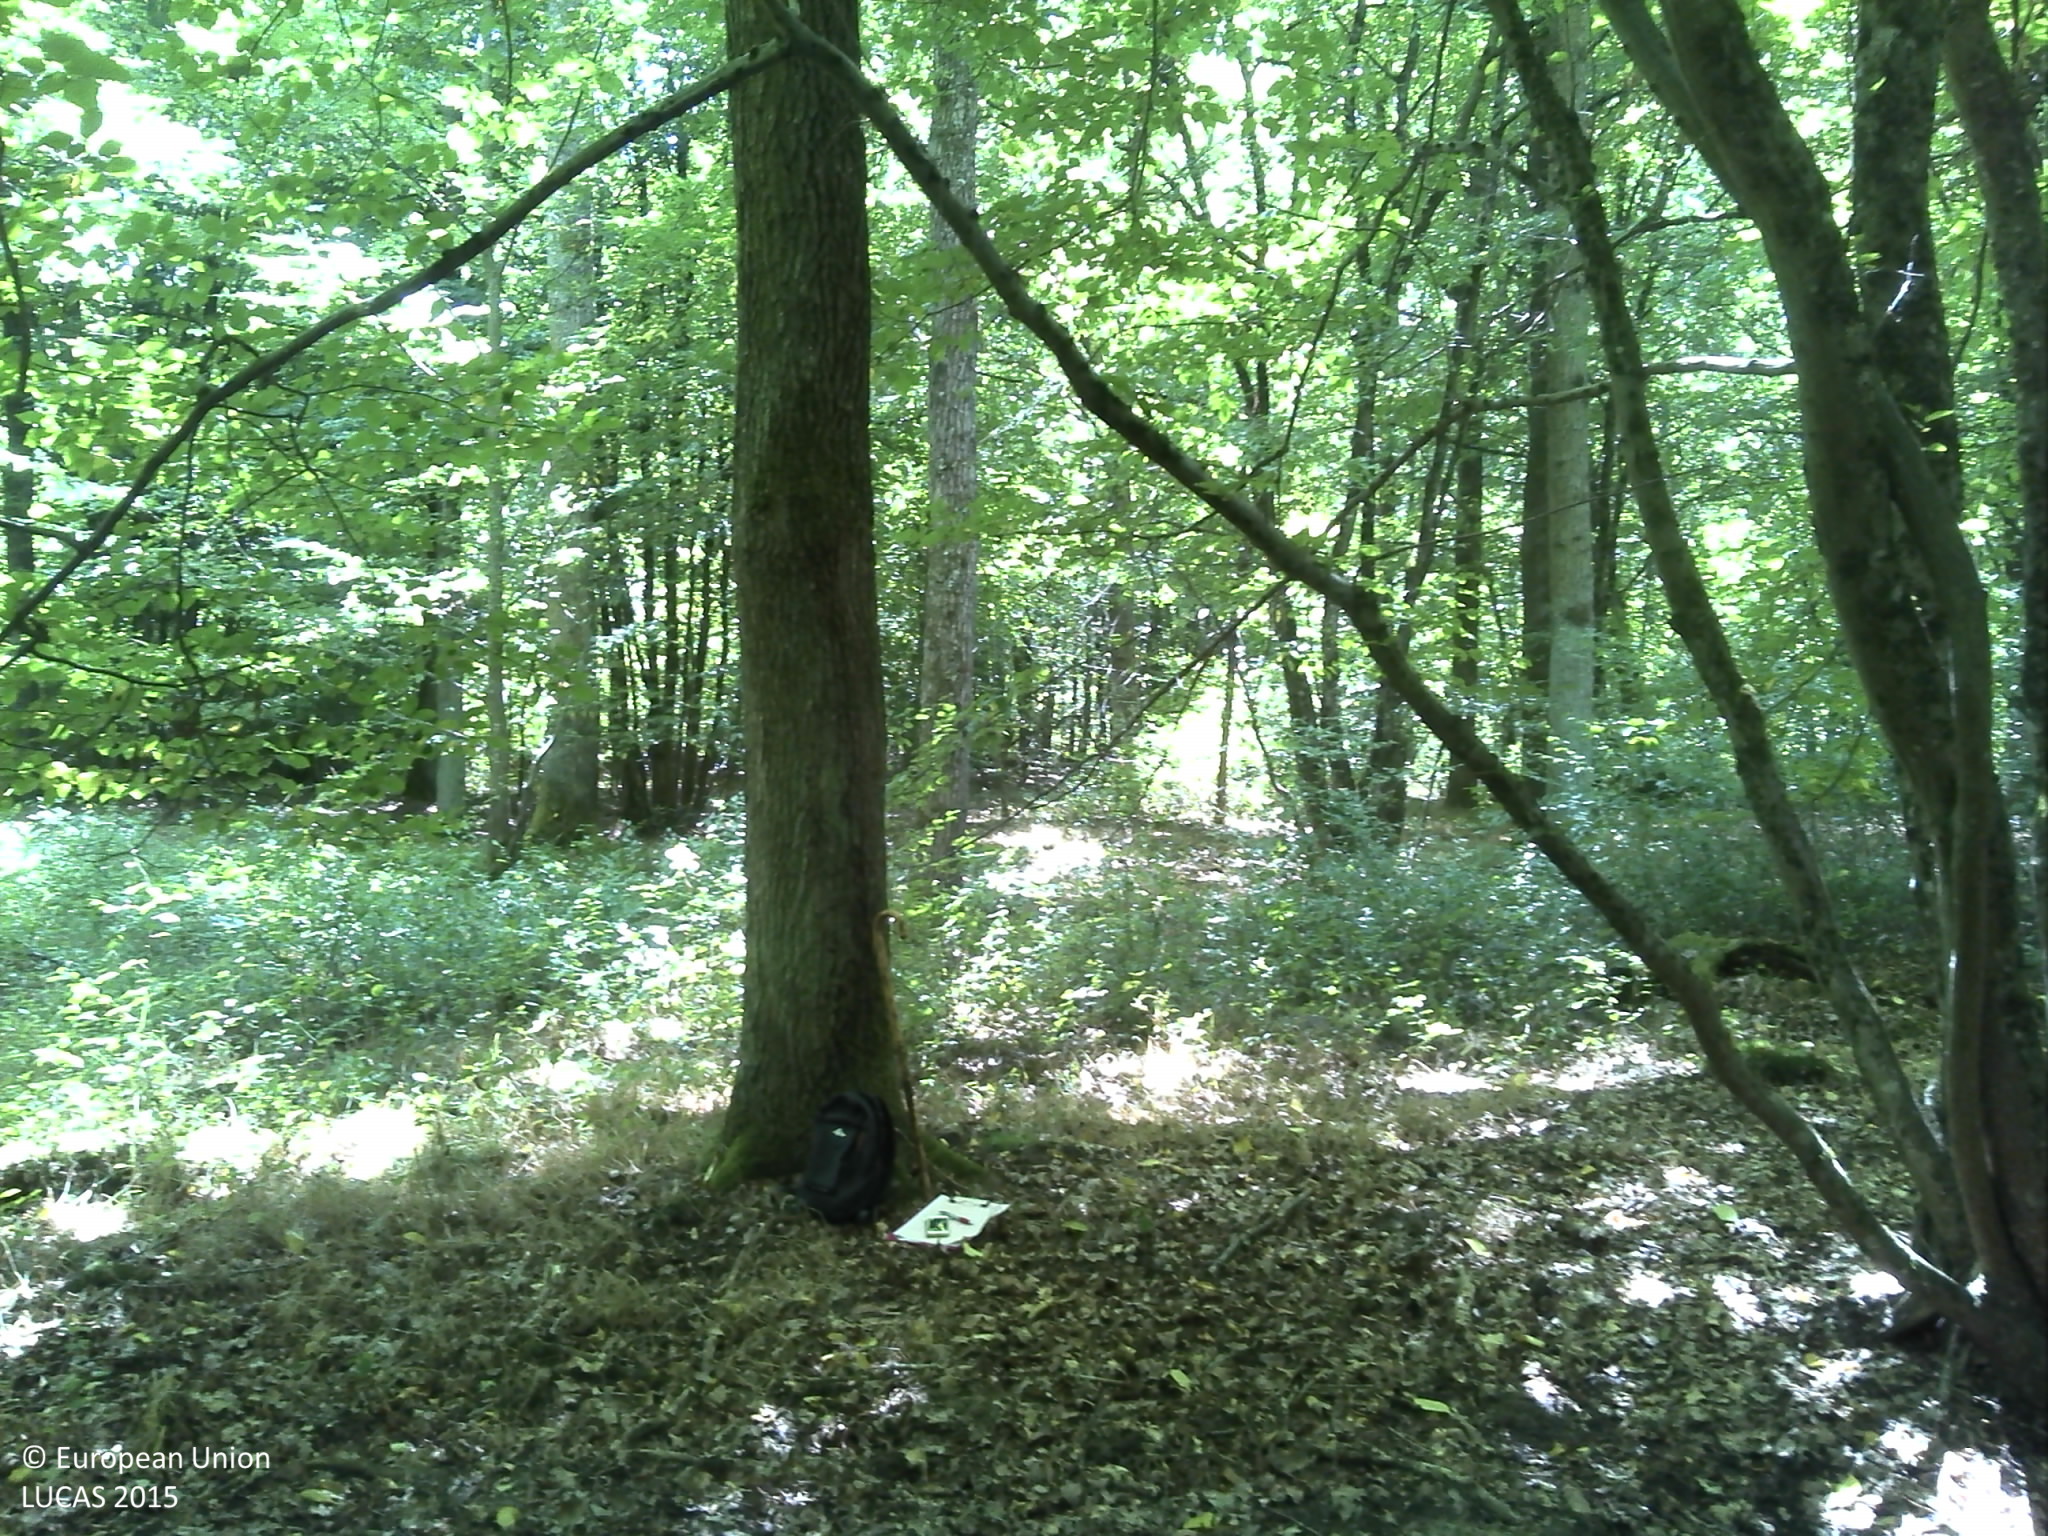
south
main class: Woodland
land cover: Broadleaved woodland
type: mesophytic deciduous forest
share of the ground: > 75 %
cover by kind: broadleaved forest trees 75 %, herbaceous plants 15 %, shrubs 10 %
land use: Forestry
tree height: > 5 m
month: July
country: FR
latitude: 45.7923
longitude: 4.1234
